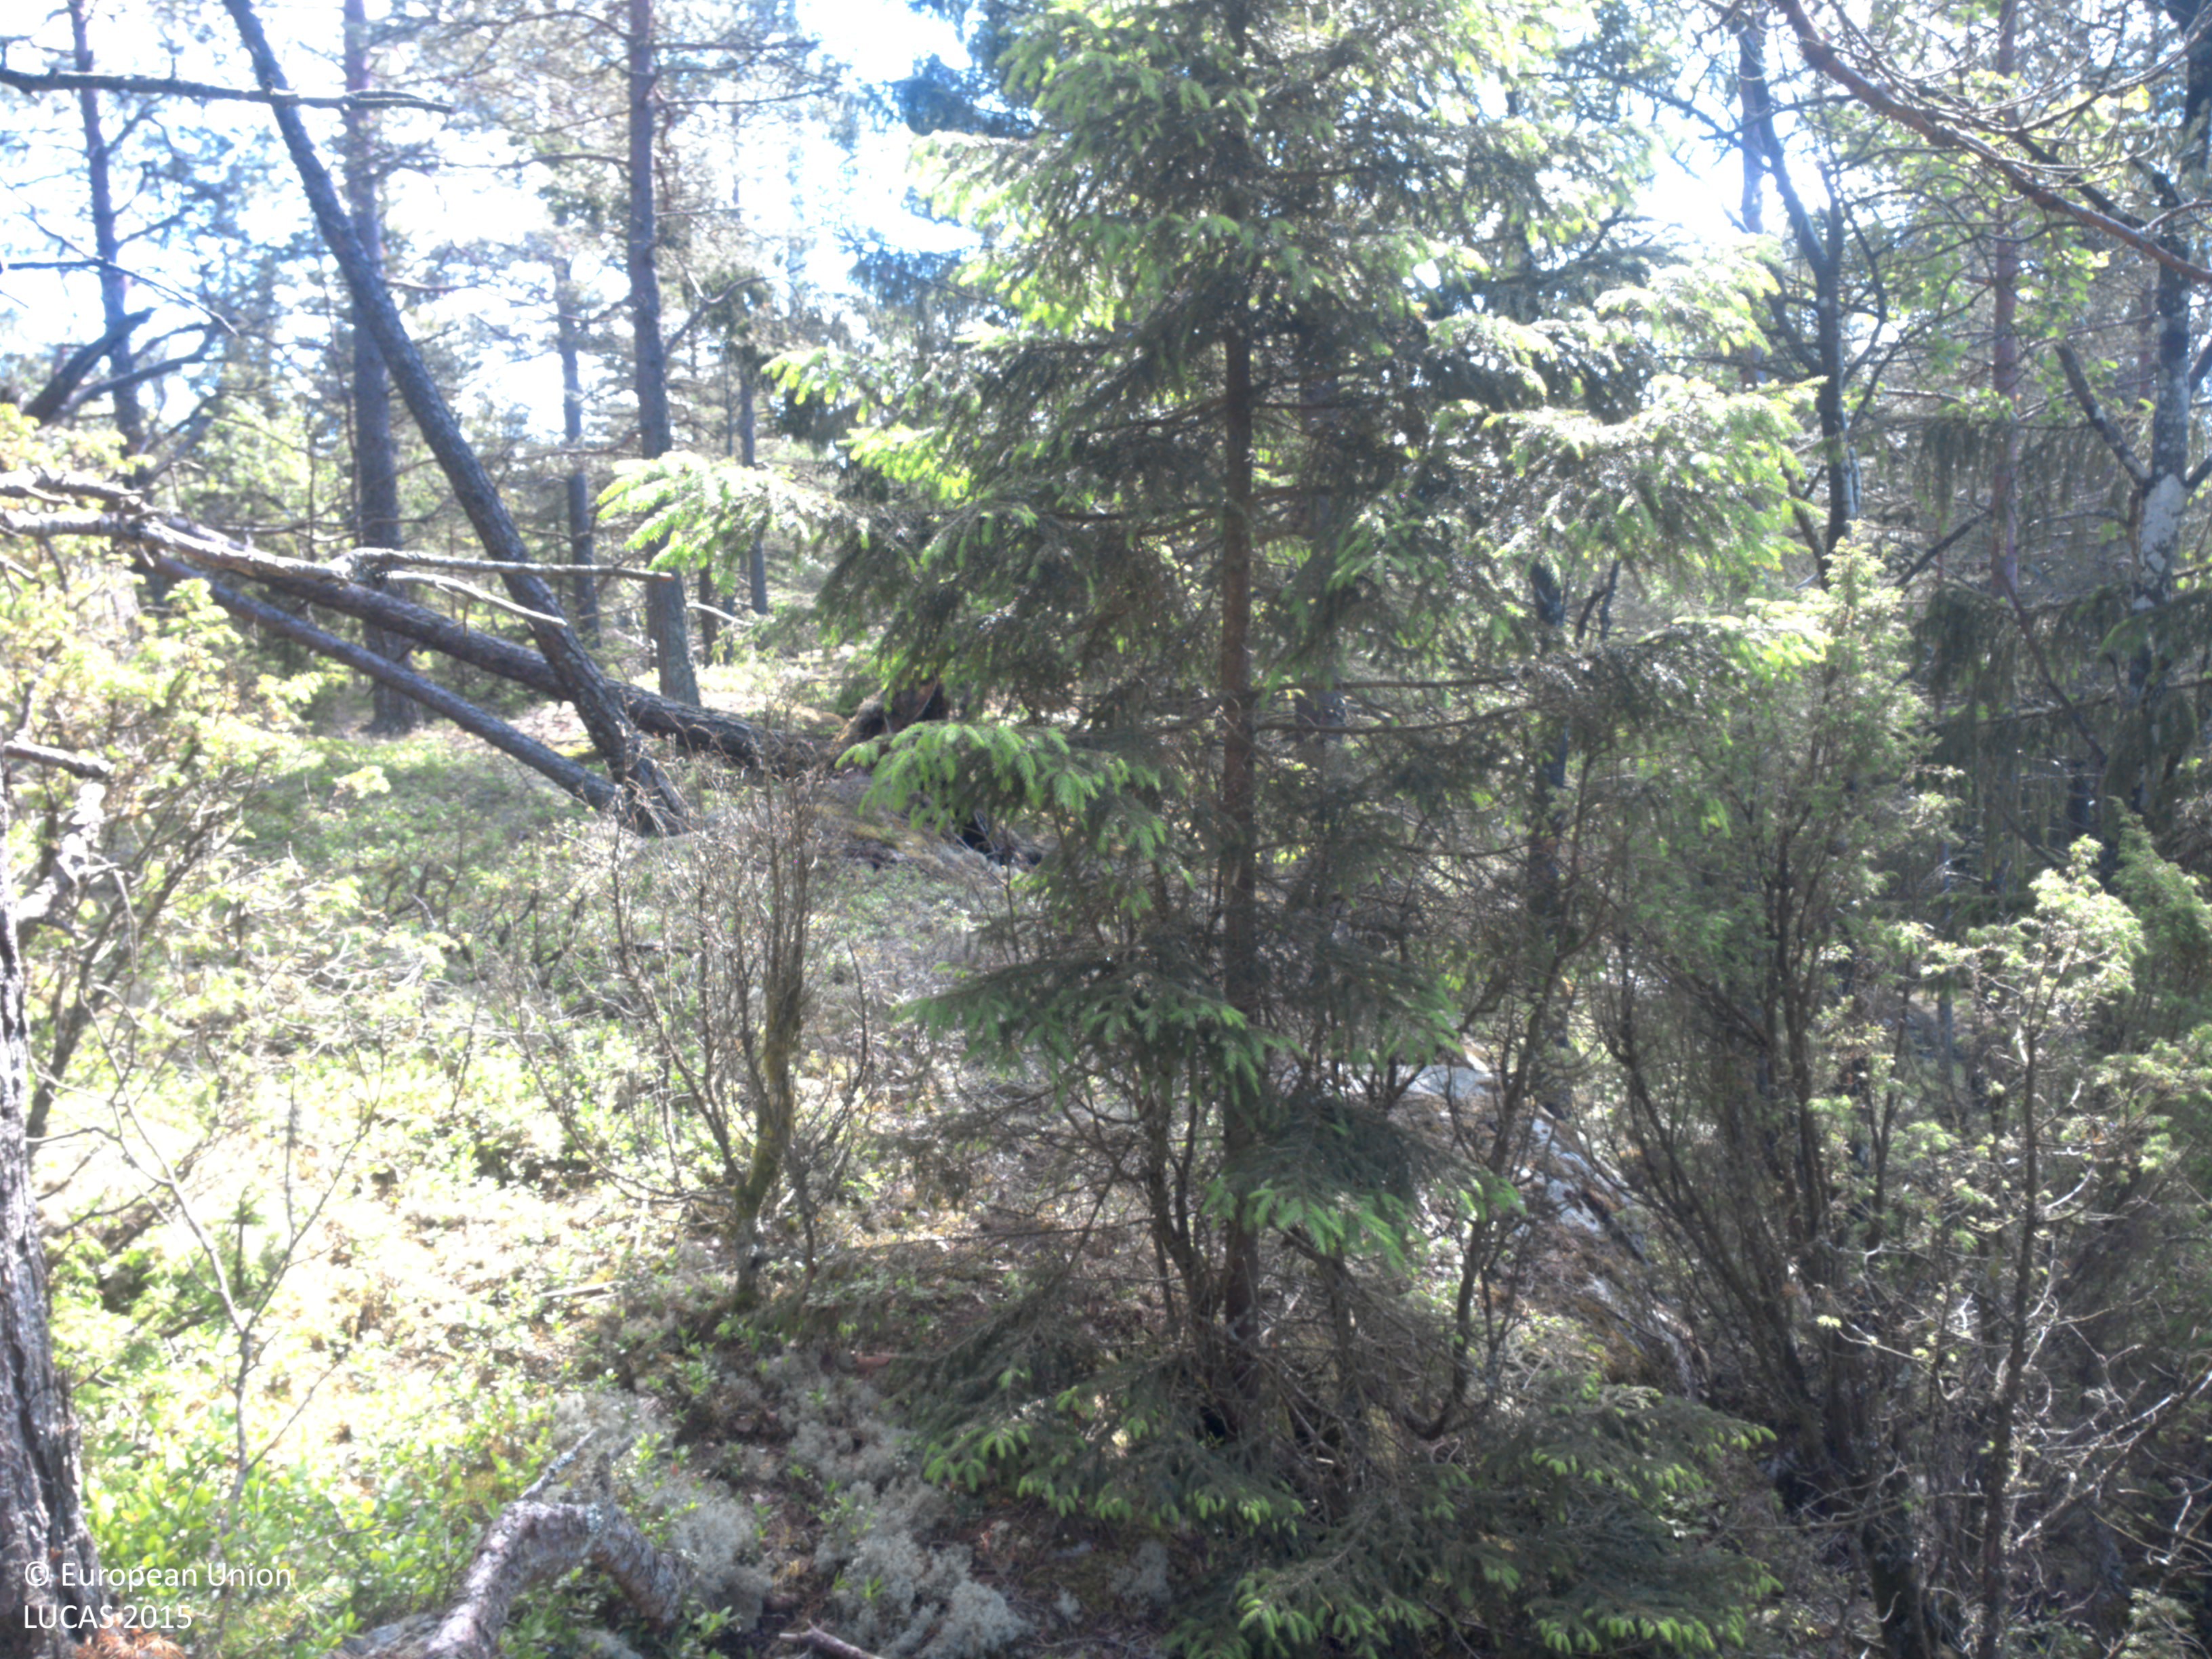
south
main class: Woodland
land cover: Pine dominated coniferous woodland
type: boreal forest
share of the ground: 50 - 75 %
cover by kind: coniferous forest trees 50 %, lichens and mosses 40 %, shrubs 10 %
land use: Forestry
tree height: > 5 m
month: June
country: SE
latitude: 58.6066
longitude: 11.5285
